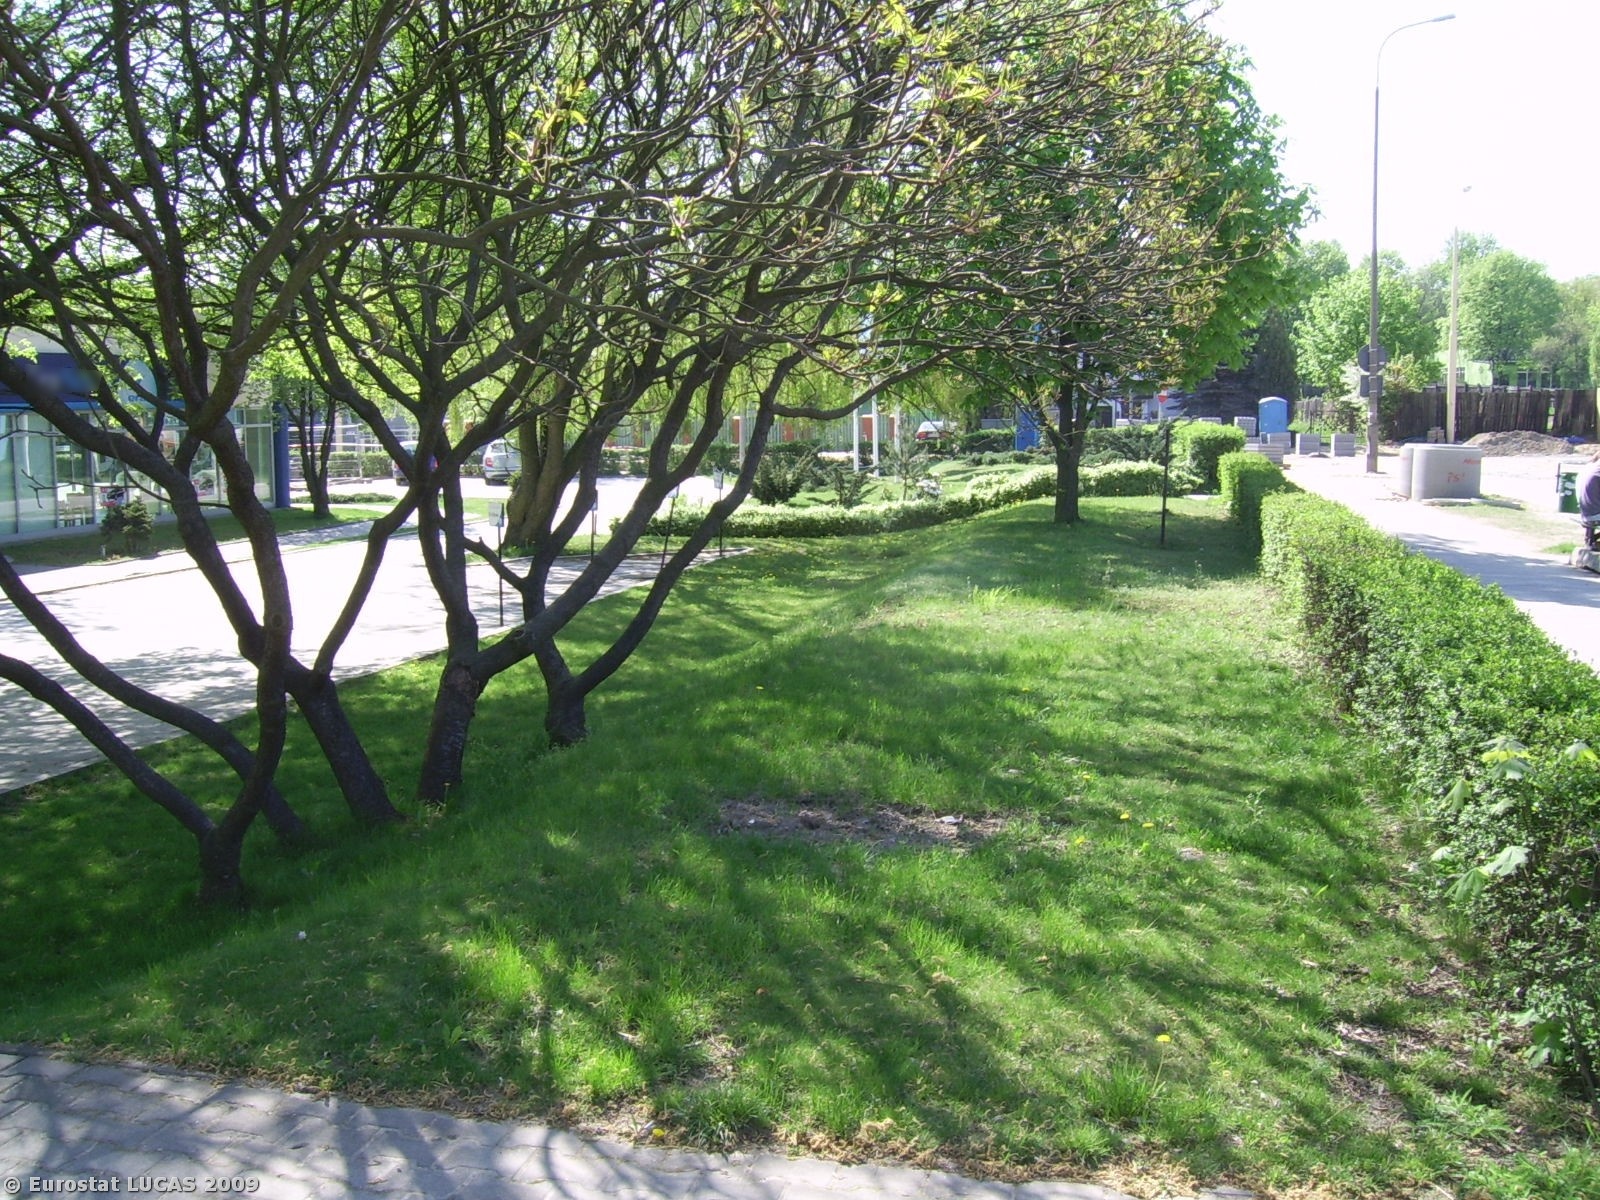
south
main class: Woodland
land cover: Broadleaved woodland
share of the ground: > 75 %
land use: Commerce, finance, business
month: April
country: PL
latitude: 52.4272
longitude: 16.9362
